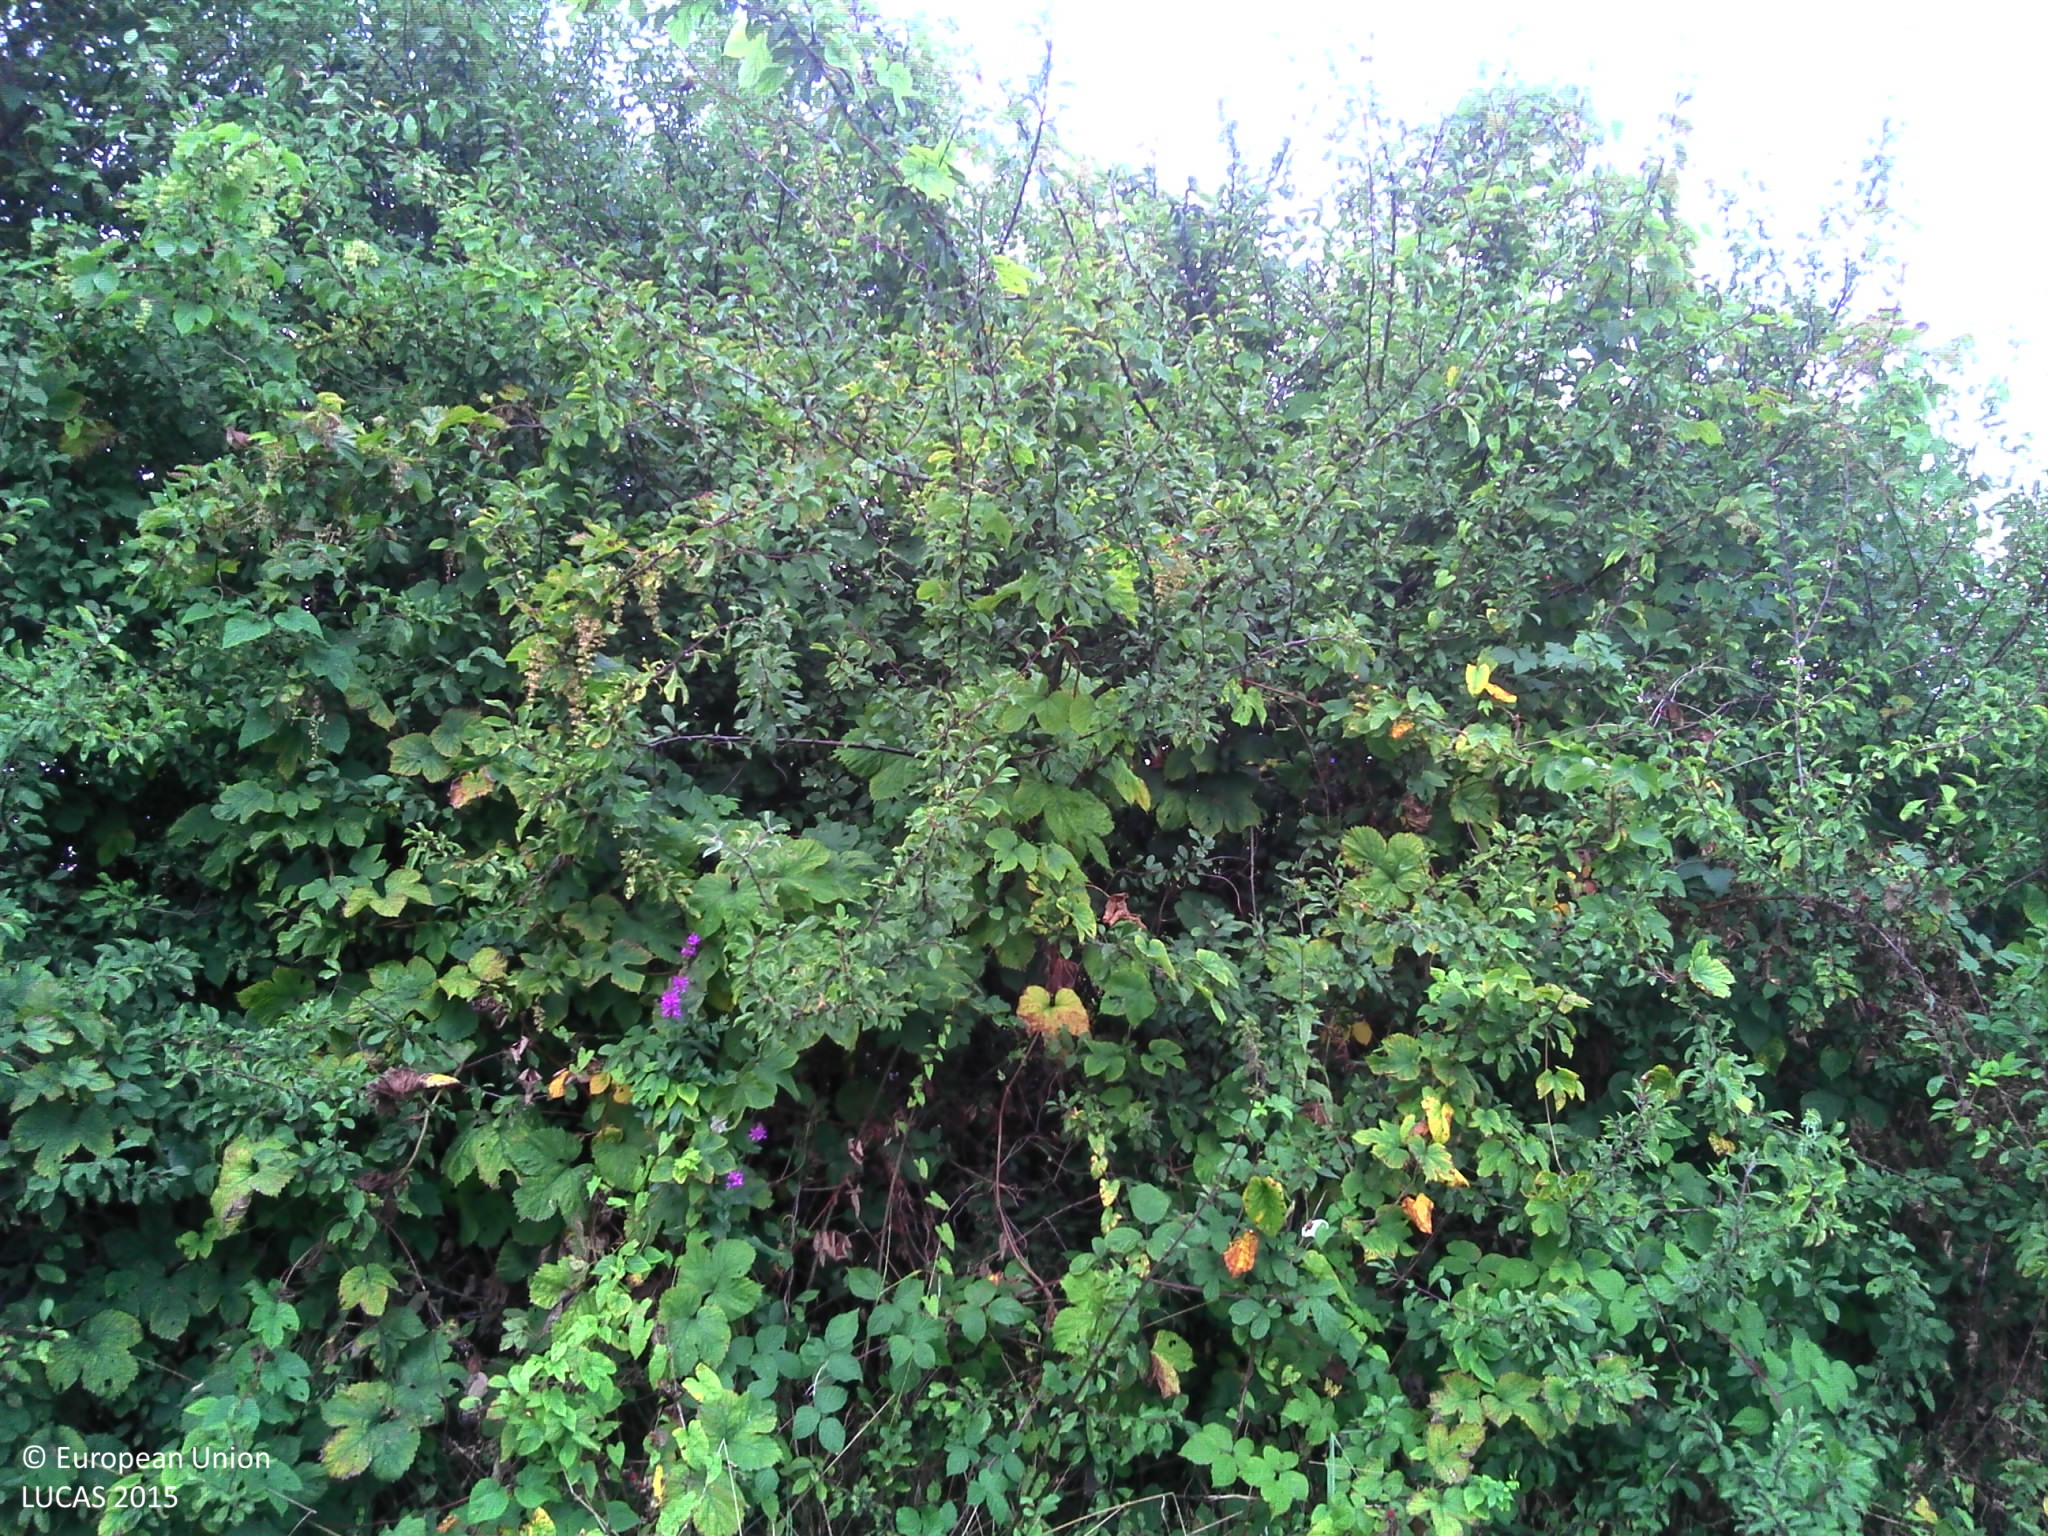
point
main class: Shrubland
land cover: Shrubland without tree cover
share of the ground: > 75 %
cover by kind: shrubs 90 %, herbaceous plants 10 %
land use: Railway transport
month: August
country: FR
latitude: 48.7216
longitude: 7.7035
